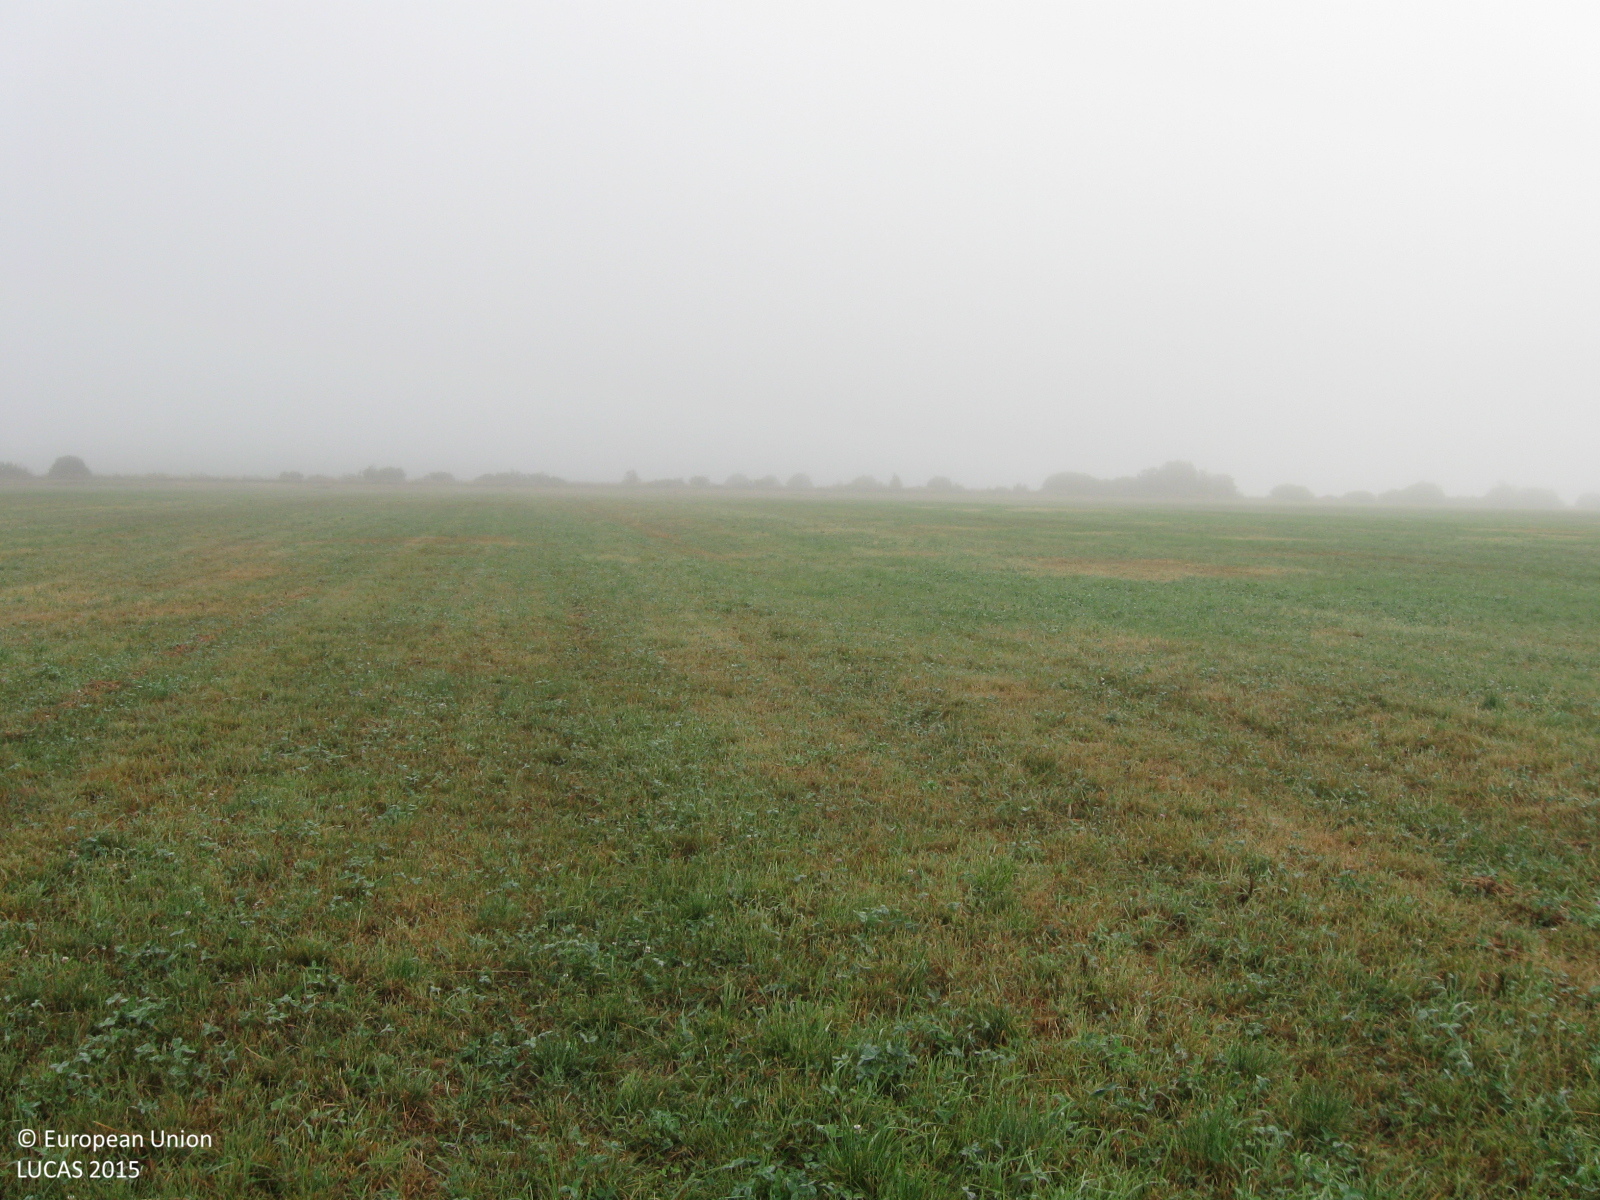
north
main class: Grassland
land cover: Grassland without tree/shrub cover
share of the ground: > 75 %
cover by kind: herbaceous plants 100 %
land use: Agriculture (excluding fallow land and kitchen gardens)
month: August
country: LT
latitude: 55.3050
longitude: 23.1639
